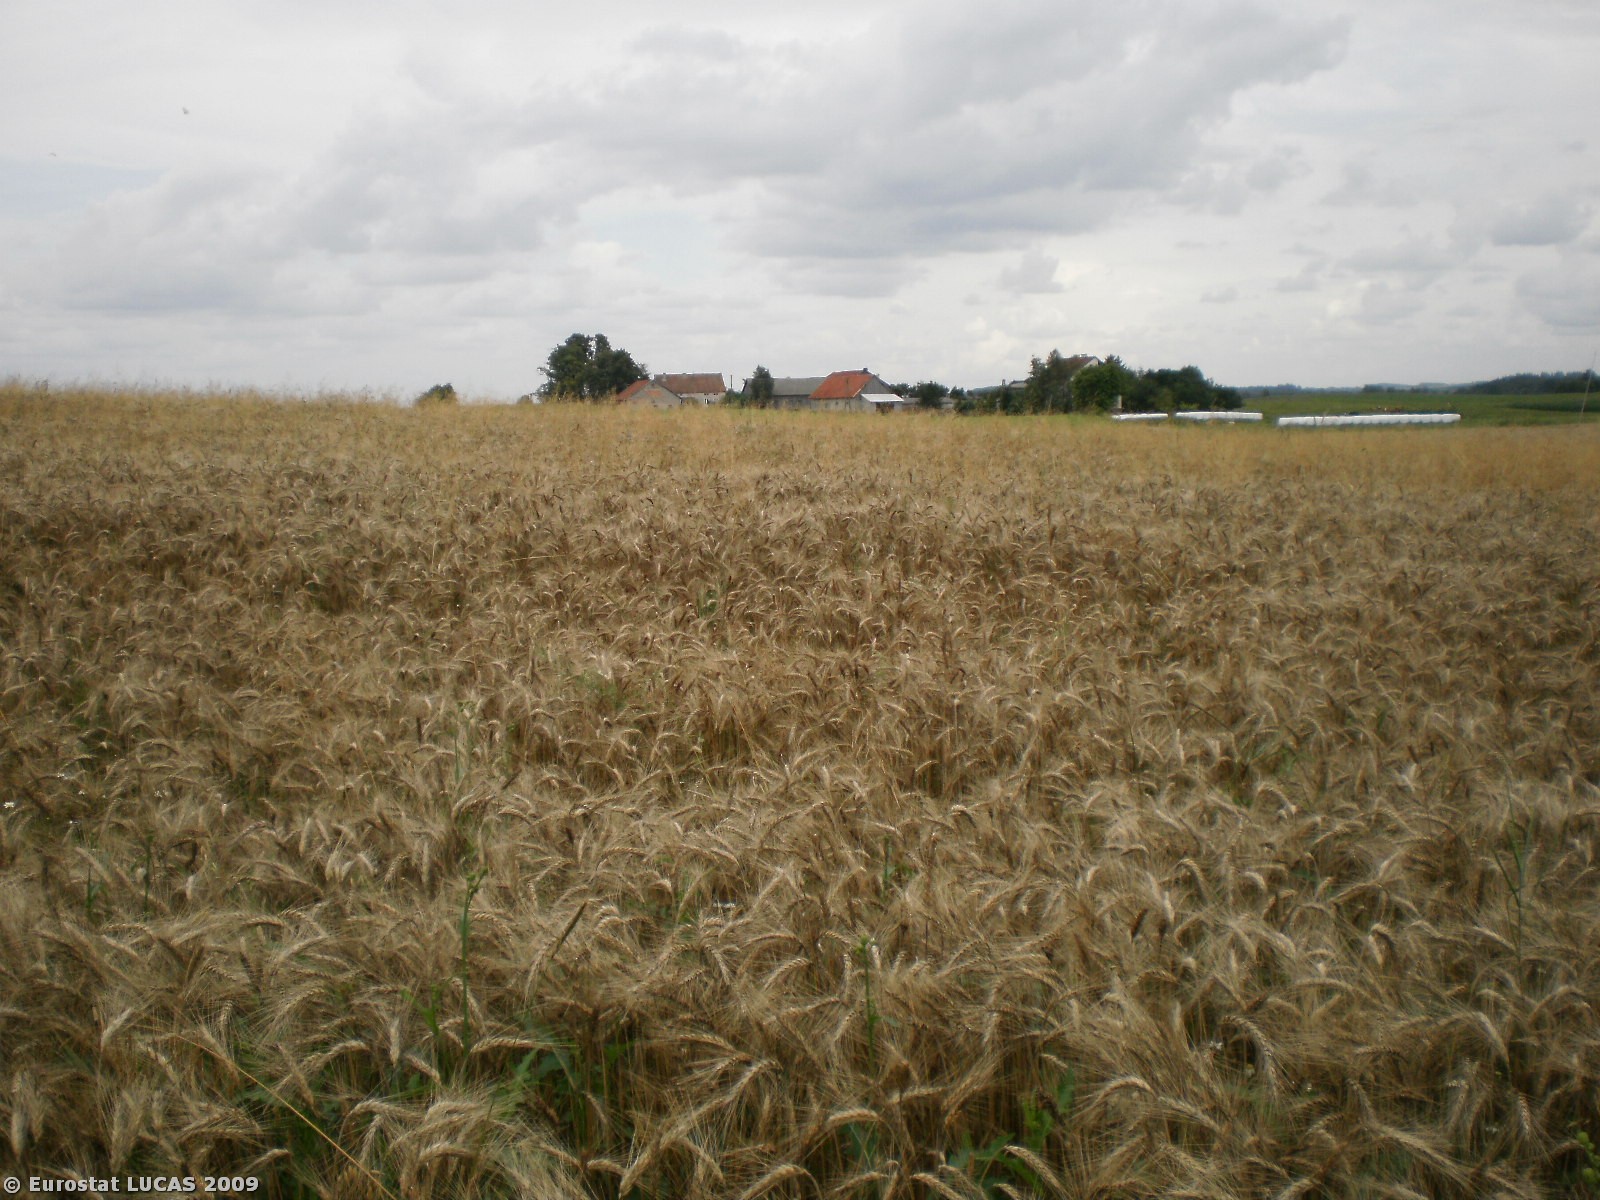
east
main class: Cropland
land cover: Triticale
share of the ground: > 75 %
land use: Agriculture (excluding fallow land and kitchen gardens)
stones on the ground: < 10 %
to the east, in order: Triticale; Grassland without tree/shrub cover
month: August
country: PL
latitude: 54.0881
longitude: 20.6944
